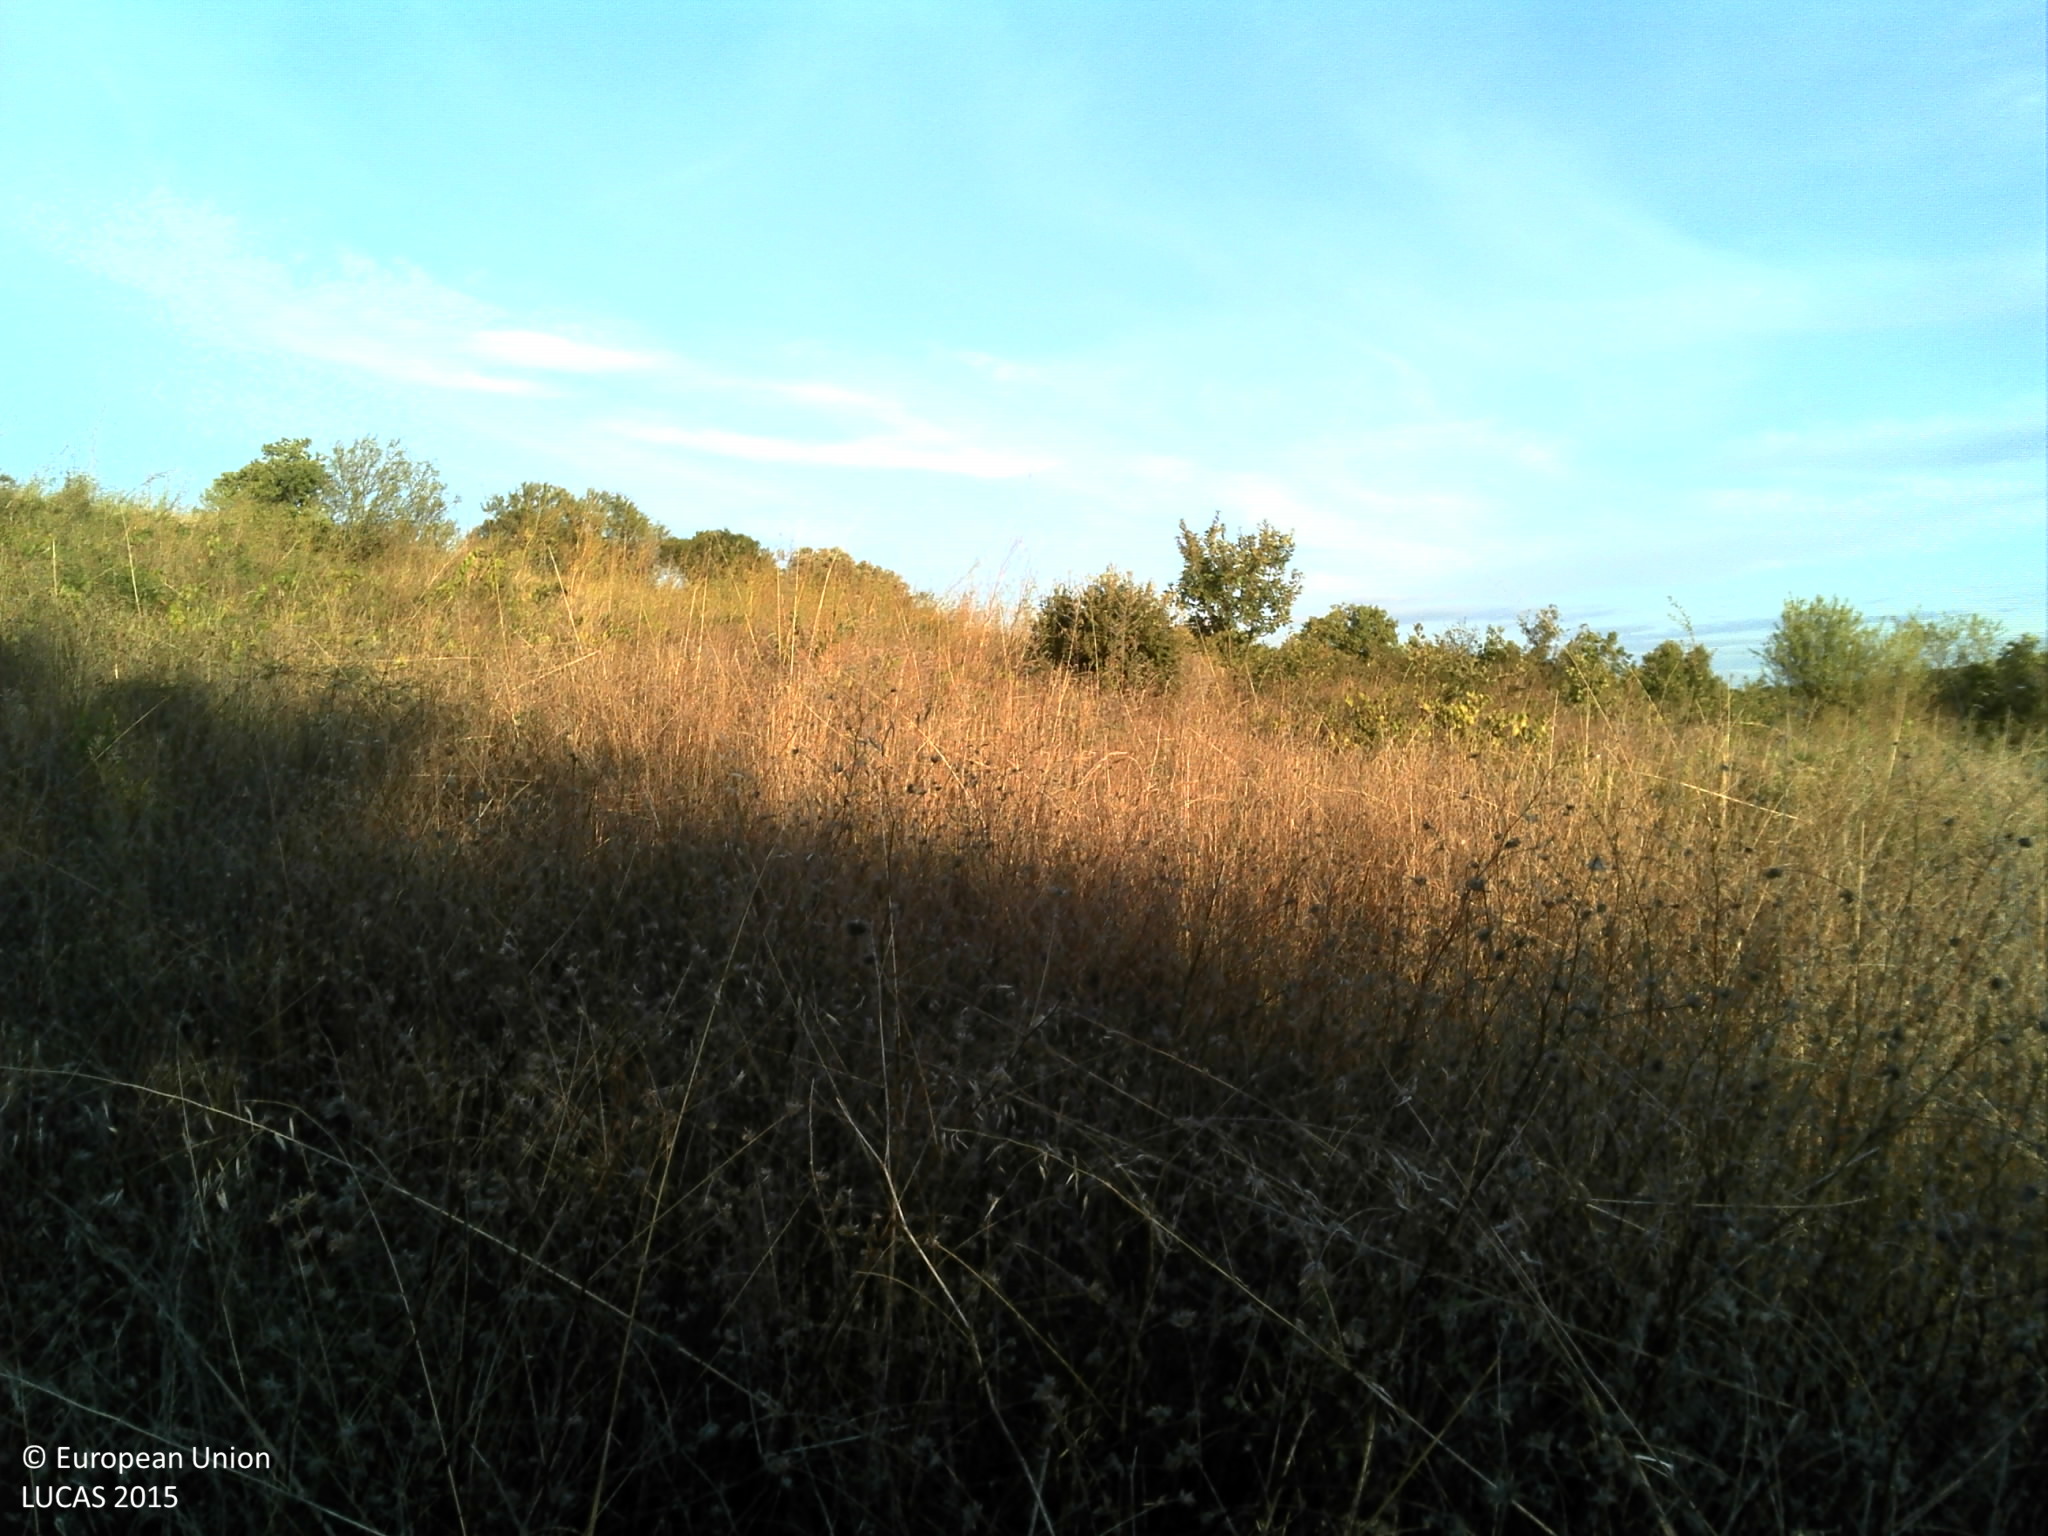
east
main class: Grassland
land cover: Spontaneously vegetated surfaces
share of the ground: > 75 %
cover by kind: herbaceous plants 95 %, shrubs 5 %
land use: Abandoned areas
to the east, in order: Spontaneously vegetated surfaces; Shrubland with sparse tree cover; Spontaneously vegetated surfaces; Abandoned hedges; Vineyards; Broadleaved woodland
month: October
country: FR
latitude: 43.5080
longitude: 3.4163
